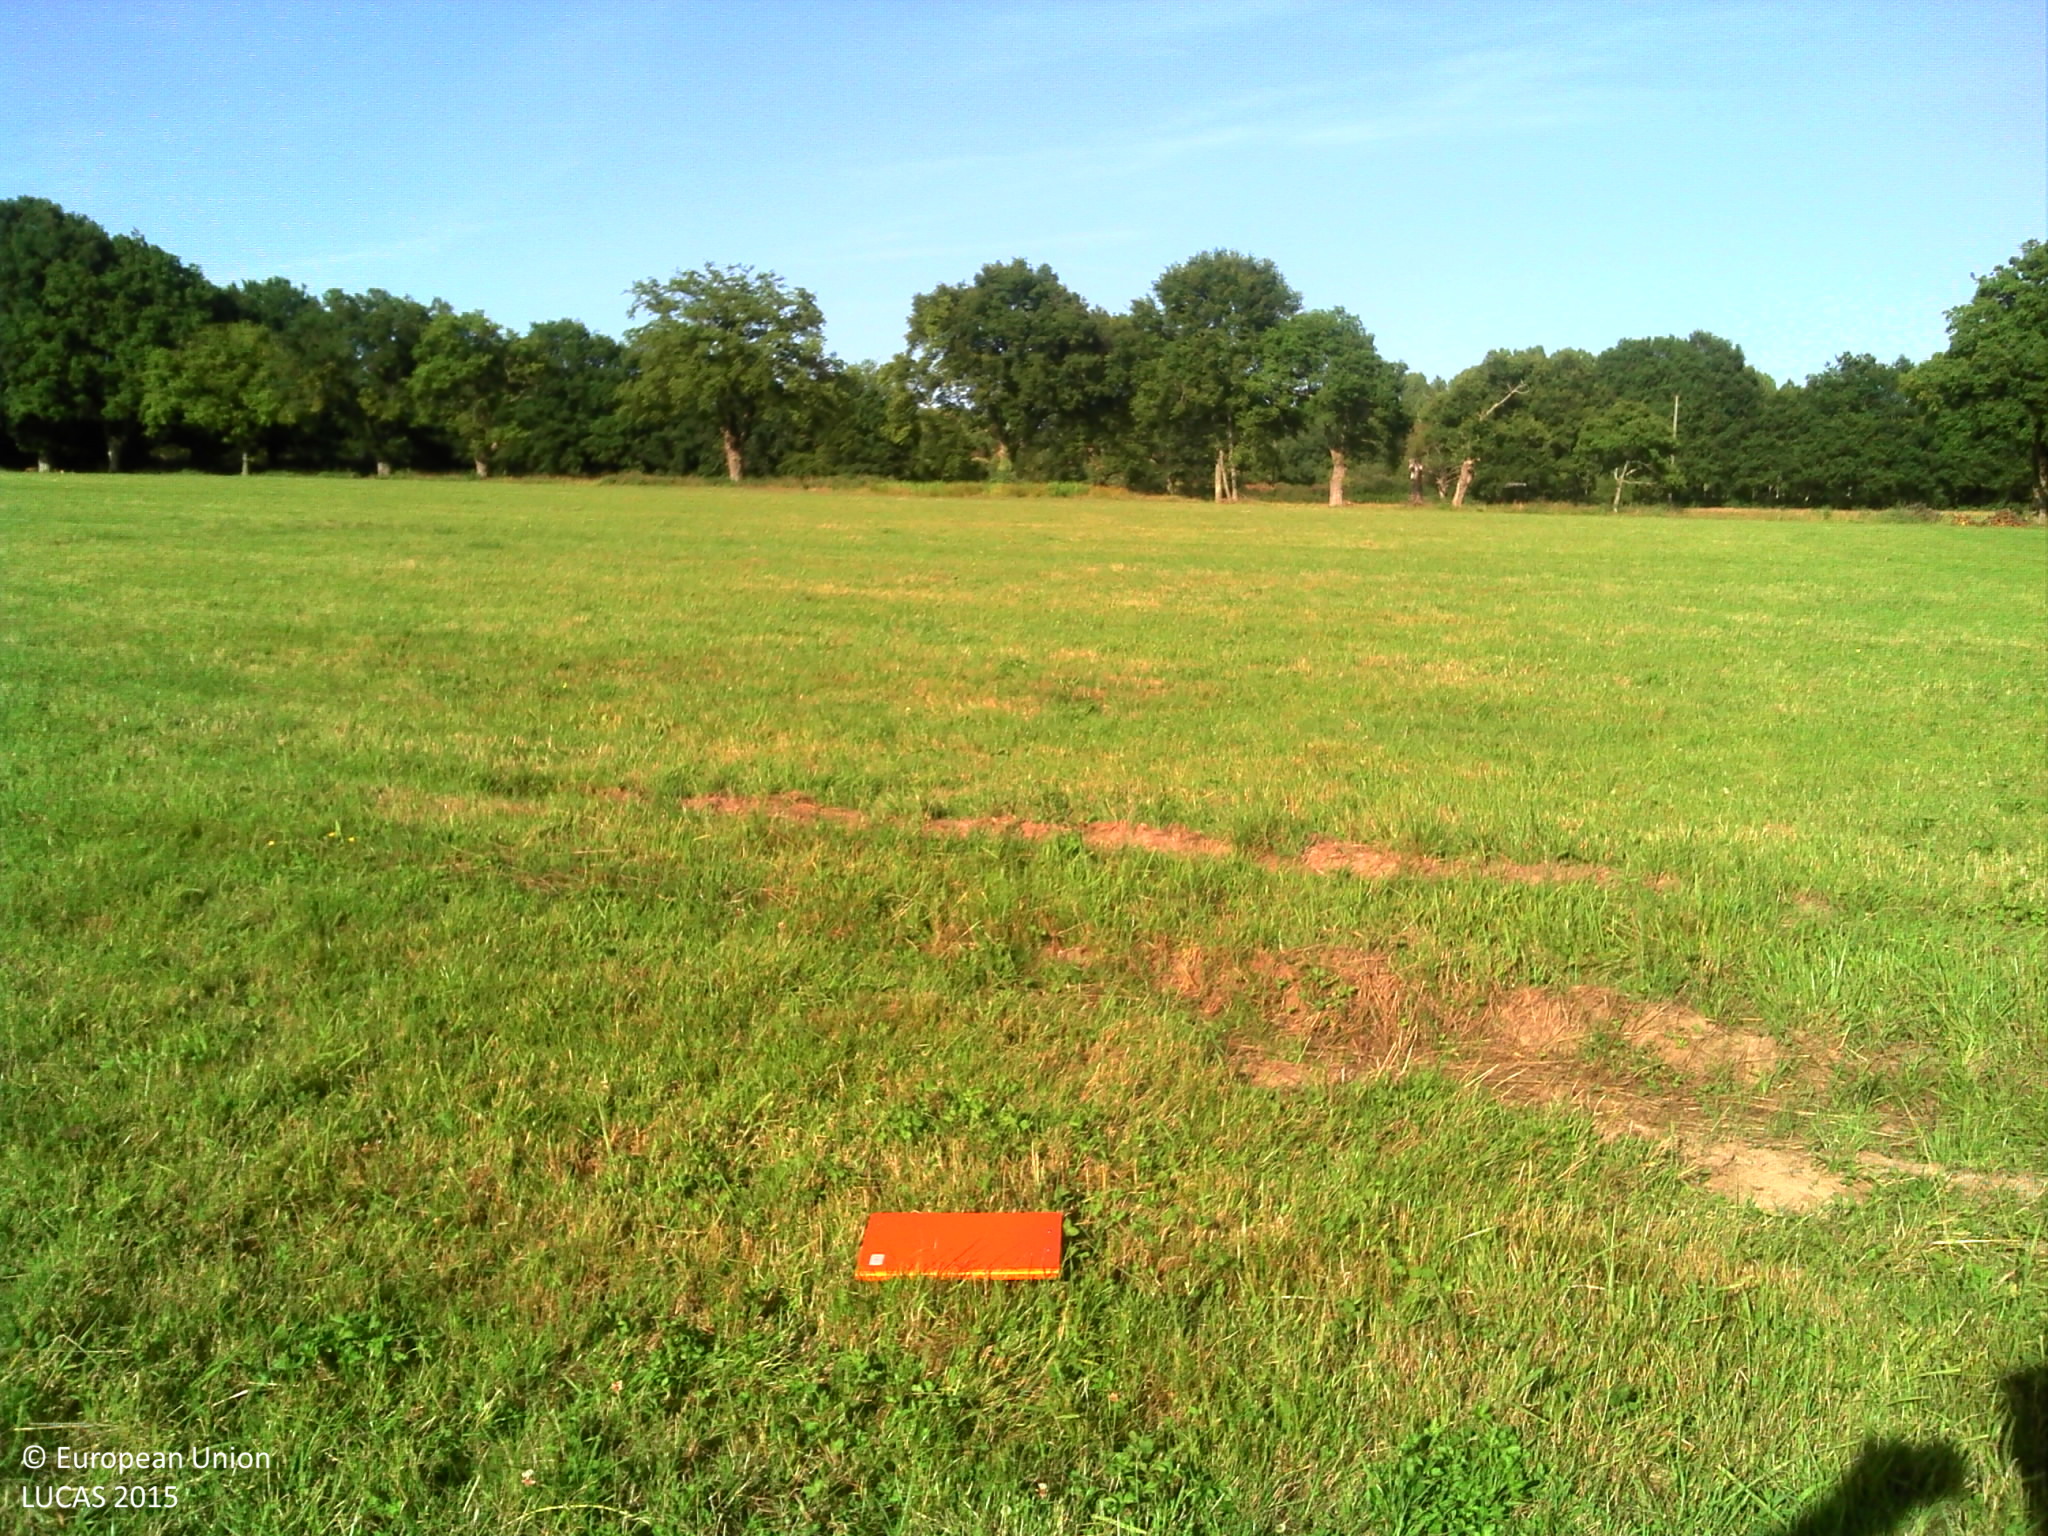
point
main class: Grassland
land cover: Grassland without tree/shrub cover
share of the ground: > 75 %
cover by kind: herbaceous plants 100 %
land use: Agriculture (excluding fallow land and kitchen gardens)
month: June
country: FR
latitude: 46.8238
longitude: 2.9569
